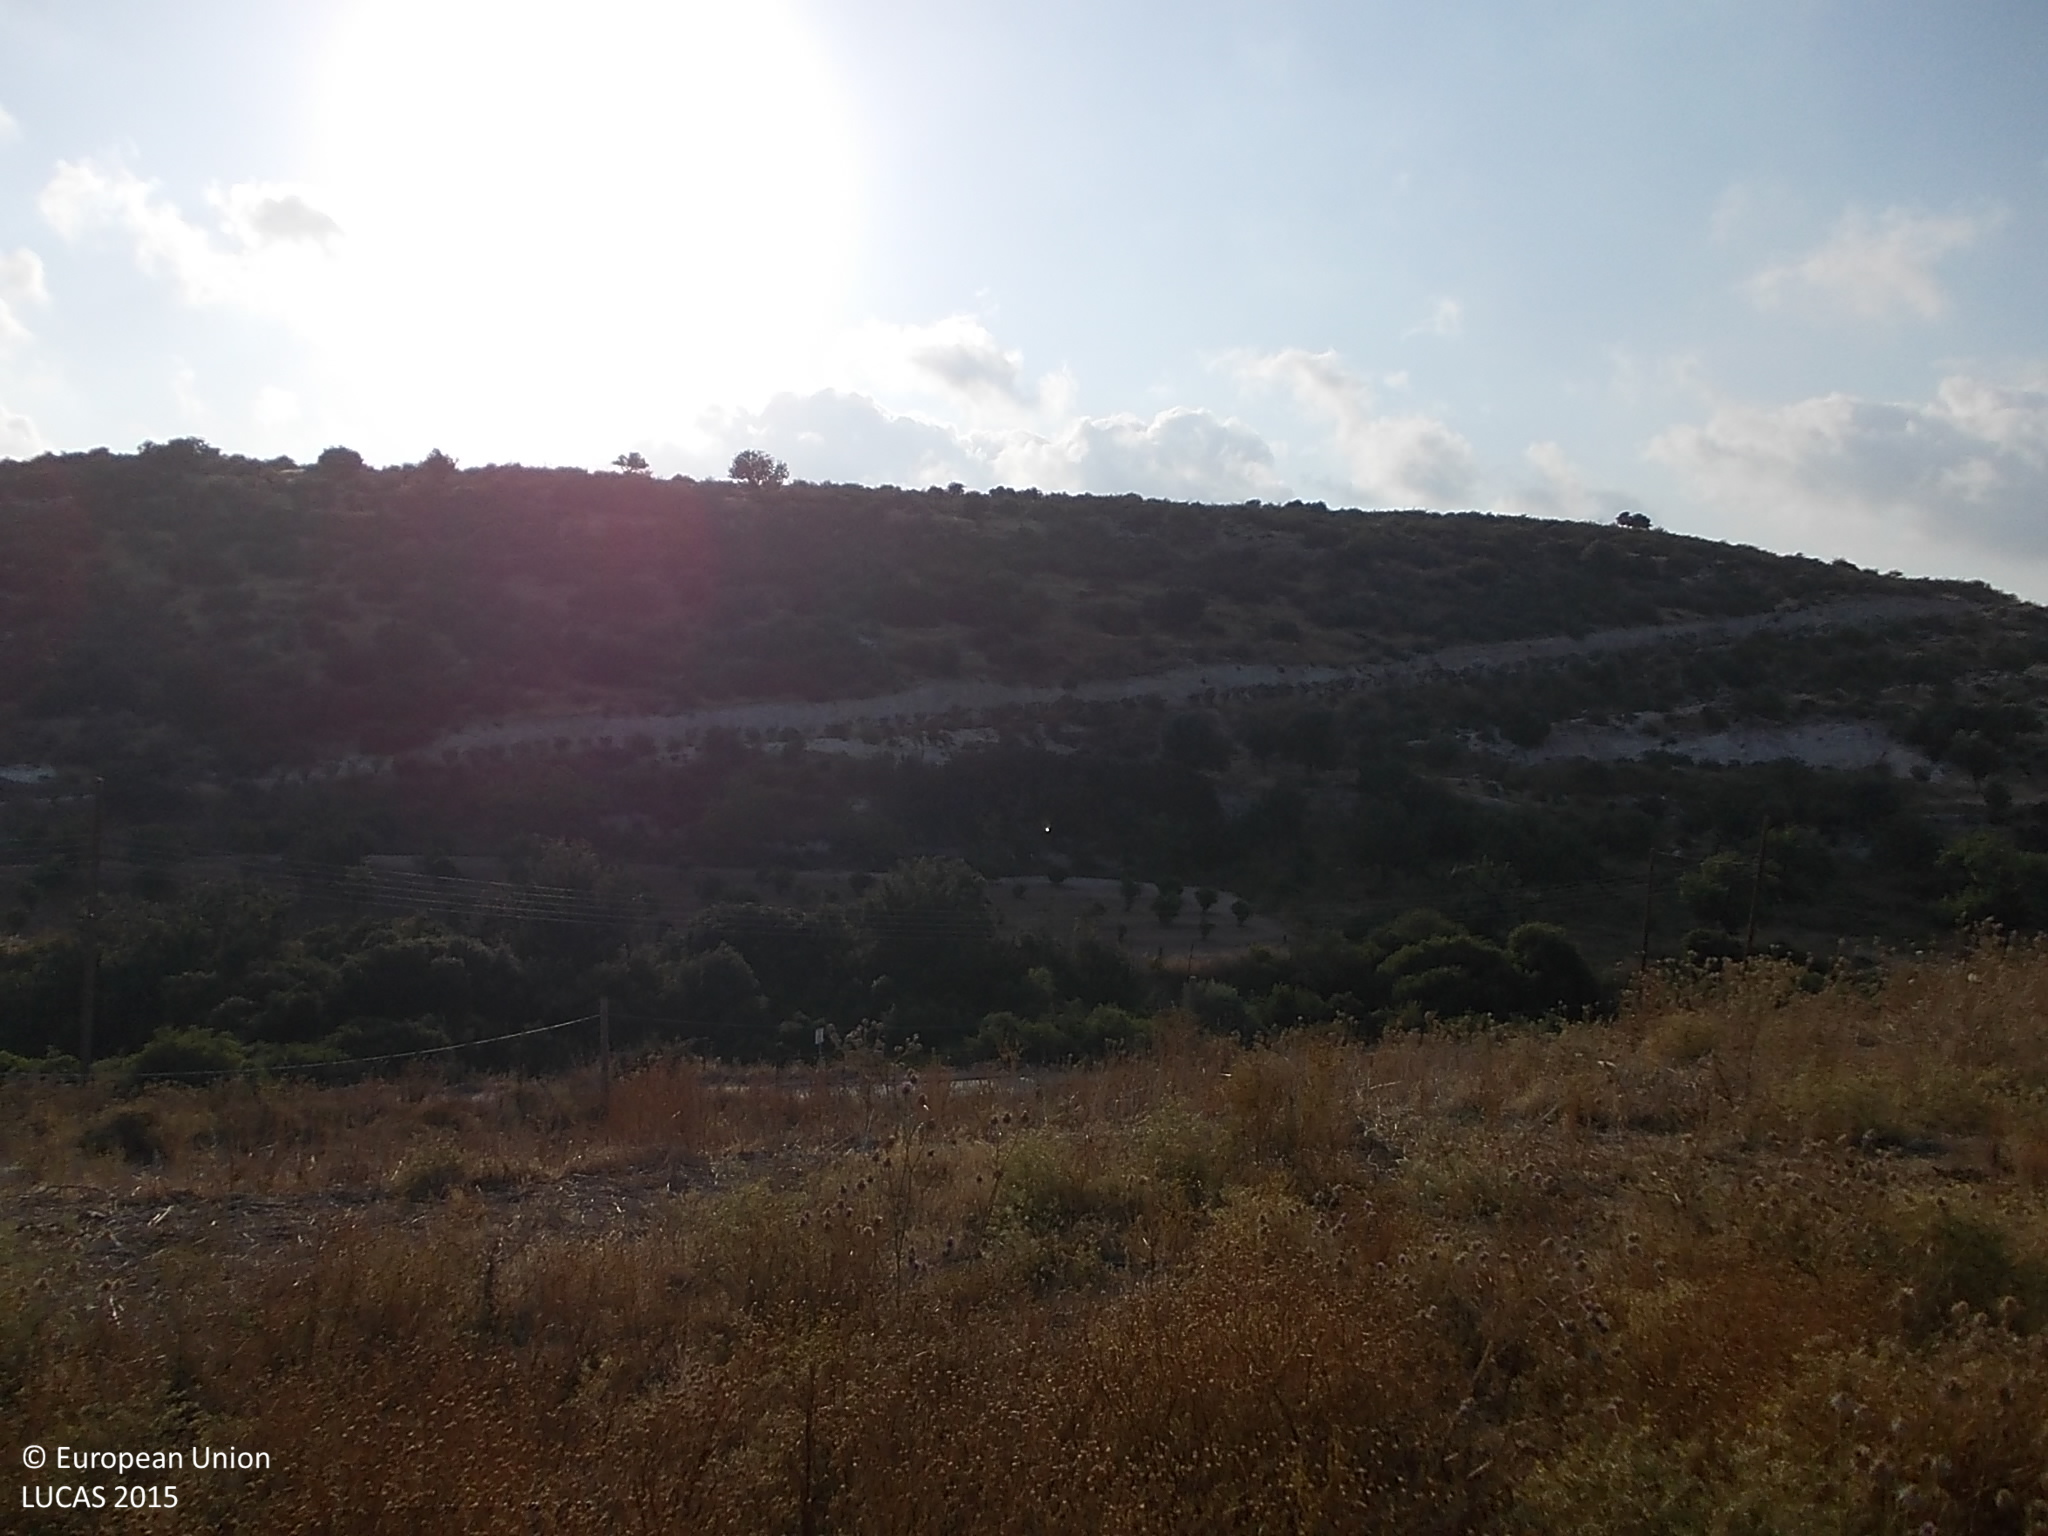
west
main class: Grassland
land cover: Grassland without tree/shrub cover
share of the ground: > 75 %
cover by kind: herbaceous plants 85 %, unconsolidated bare surface 15 %
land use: Logistics and storage
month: June
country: CY
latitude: 34.6850
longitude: 32.6912
